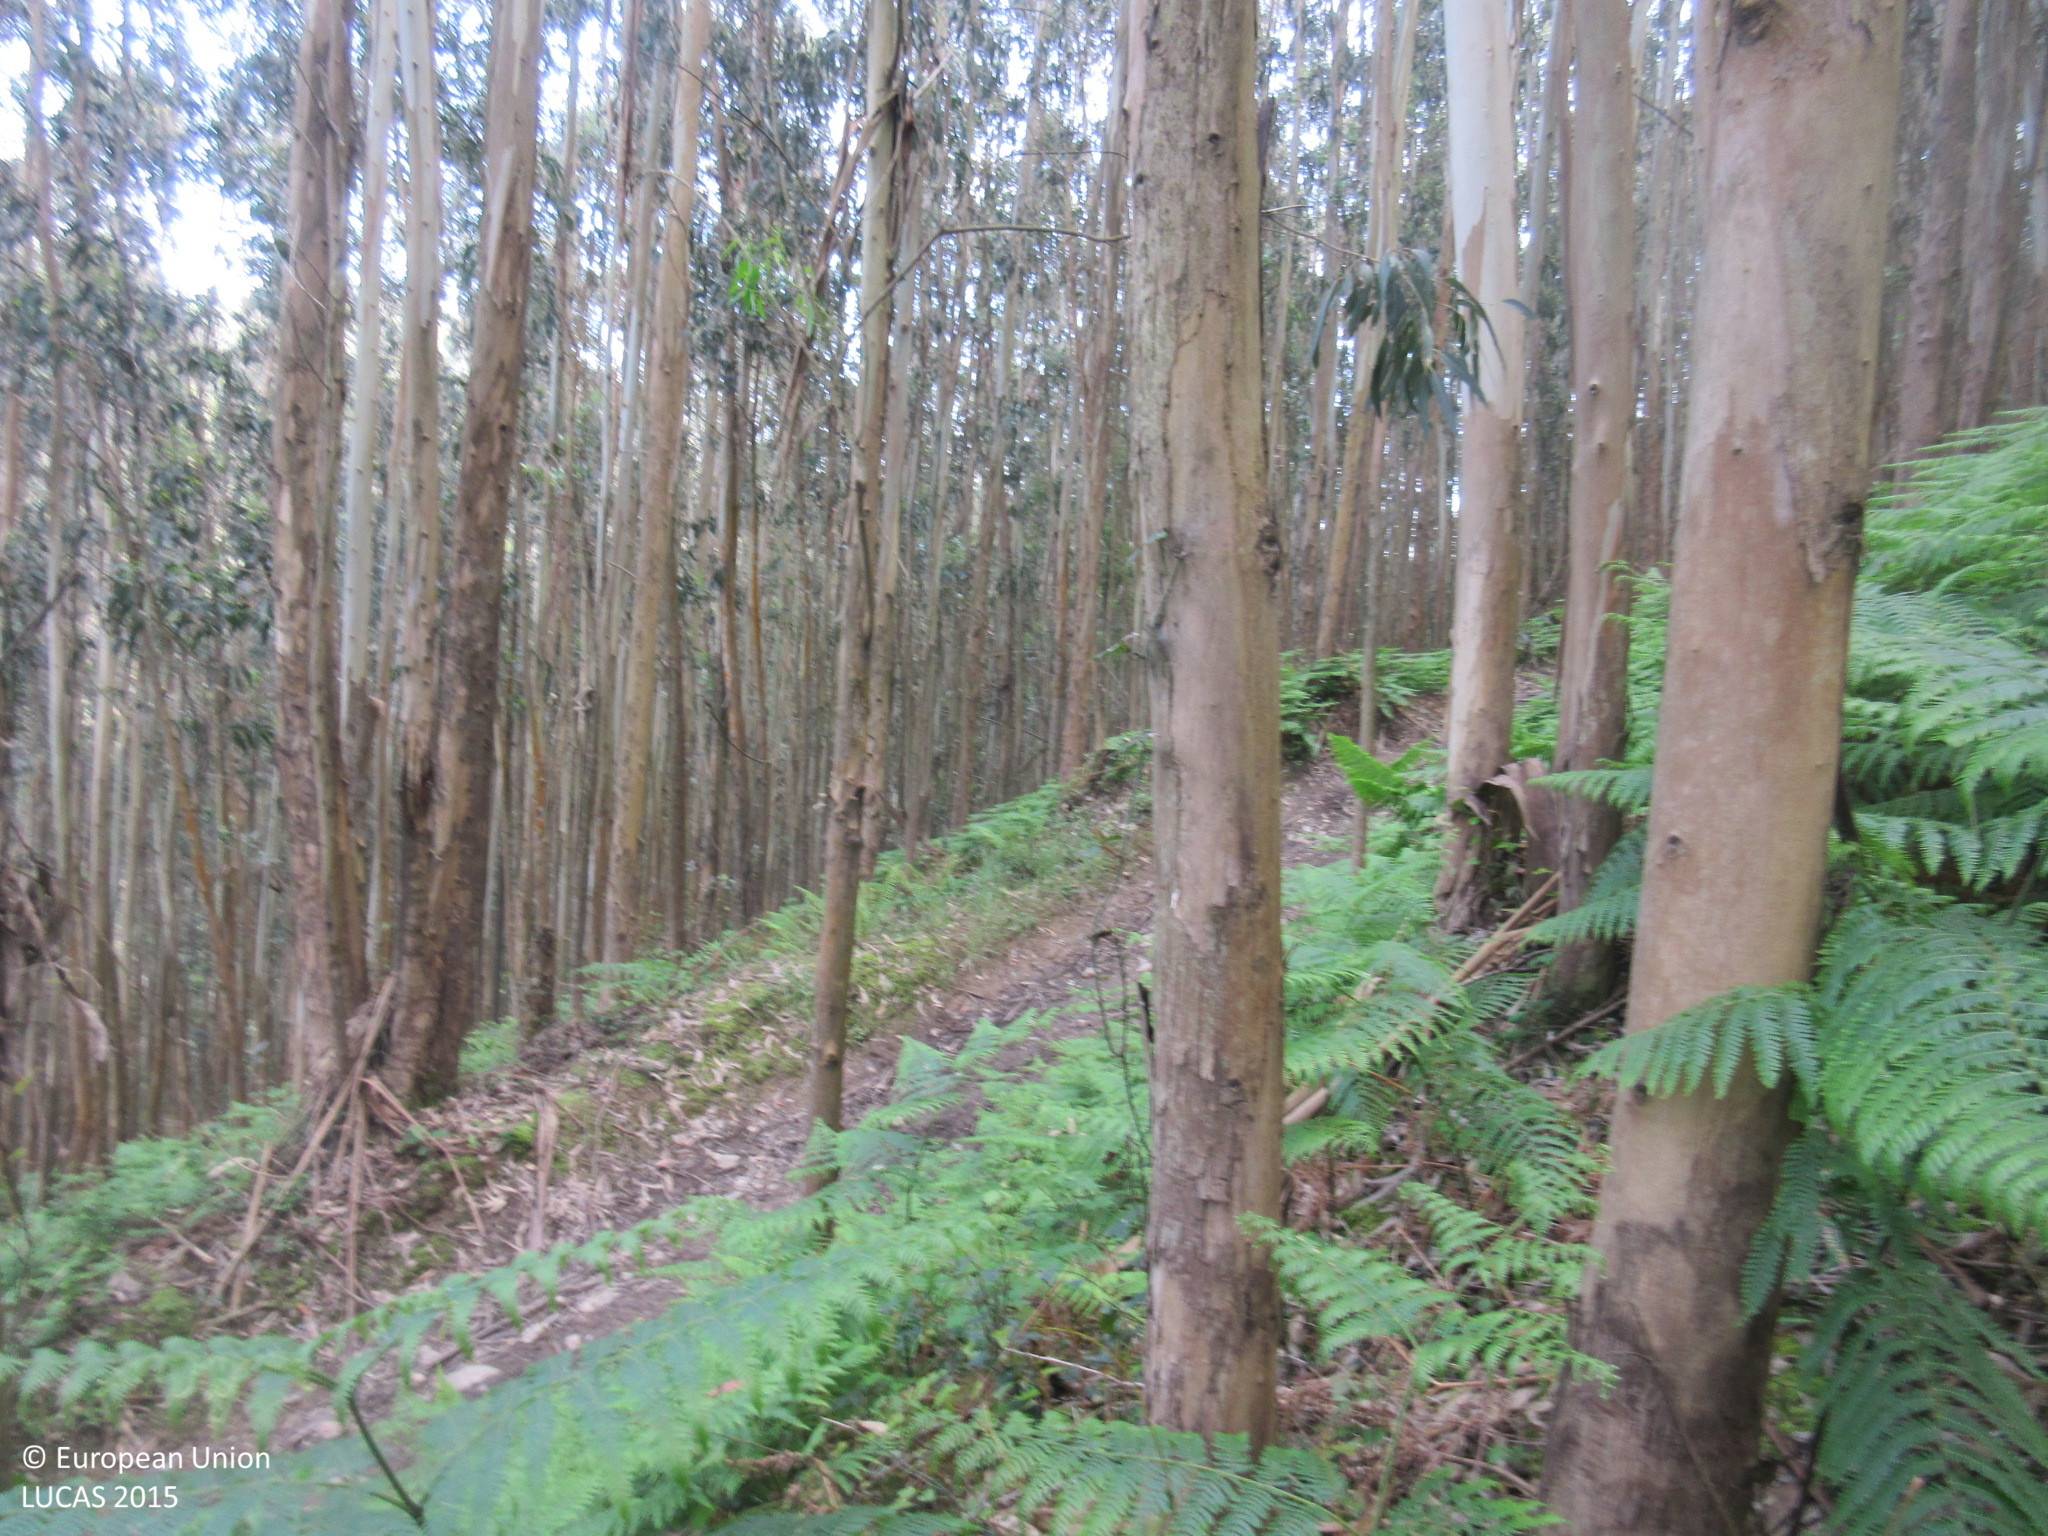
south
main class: Woodland
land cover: Broadleaved woodland
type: exotic forest
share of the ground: > 75 %
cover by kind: broadleaved forest trees 100 %
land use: Forestry
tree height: > 5 m
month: May
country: ES
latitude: 43.5681
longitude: -6.0543
